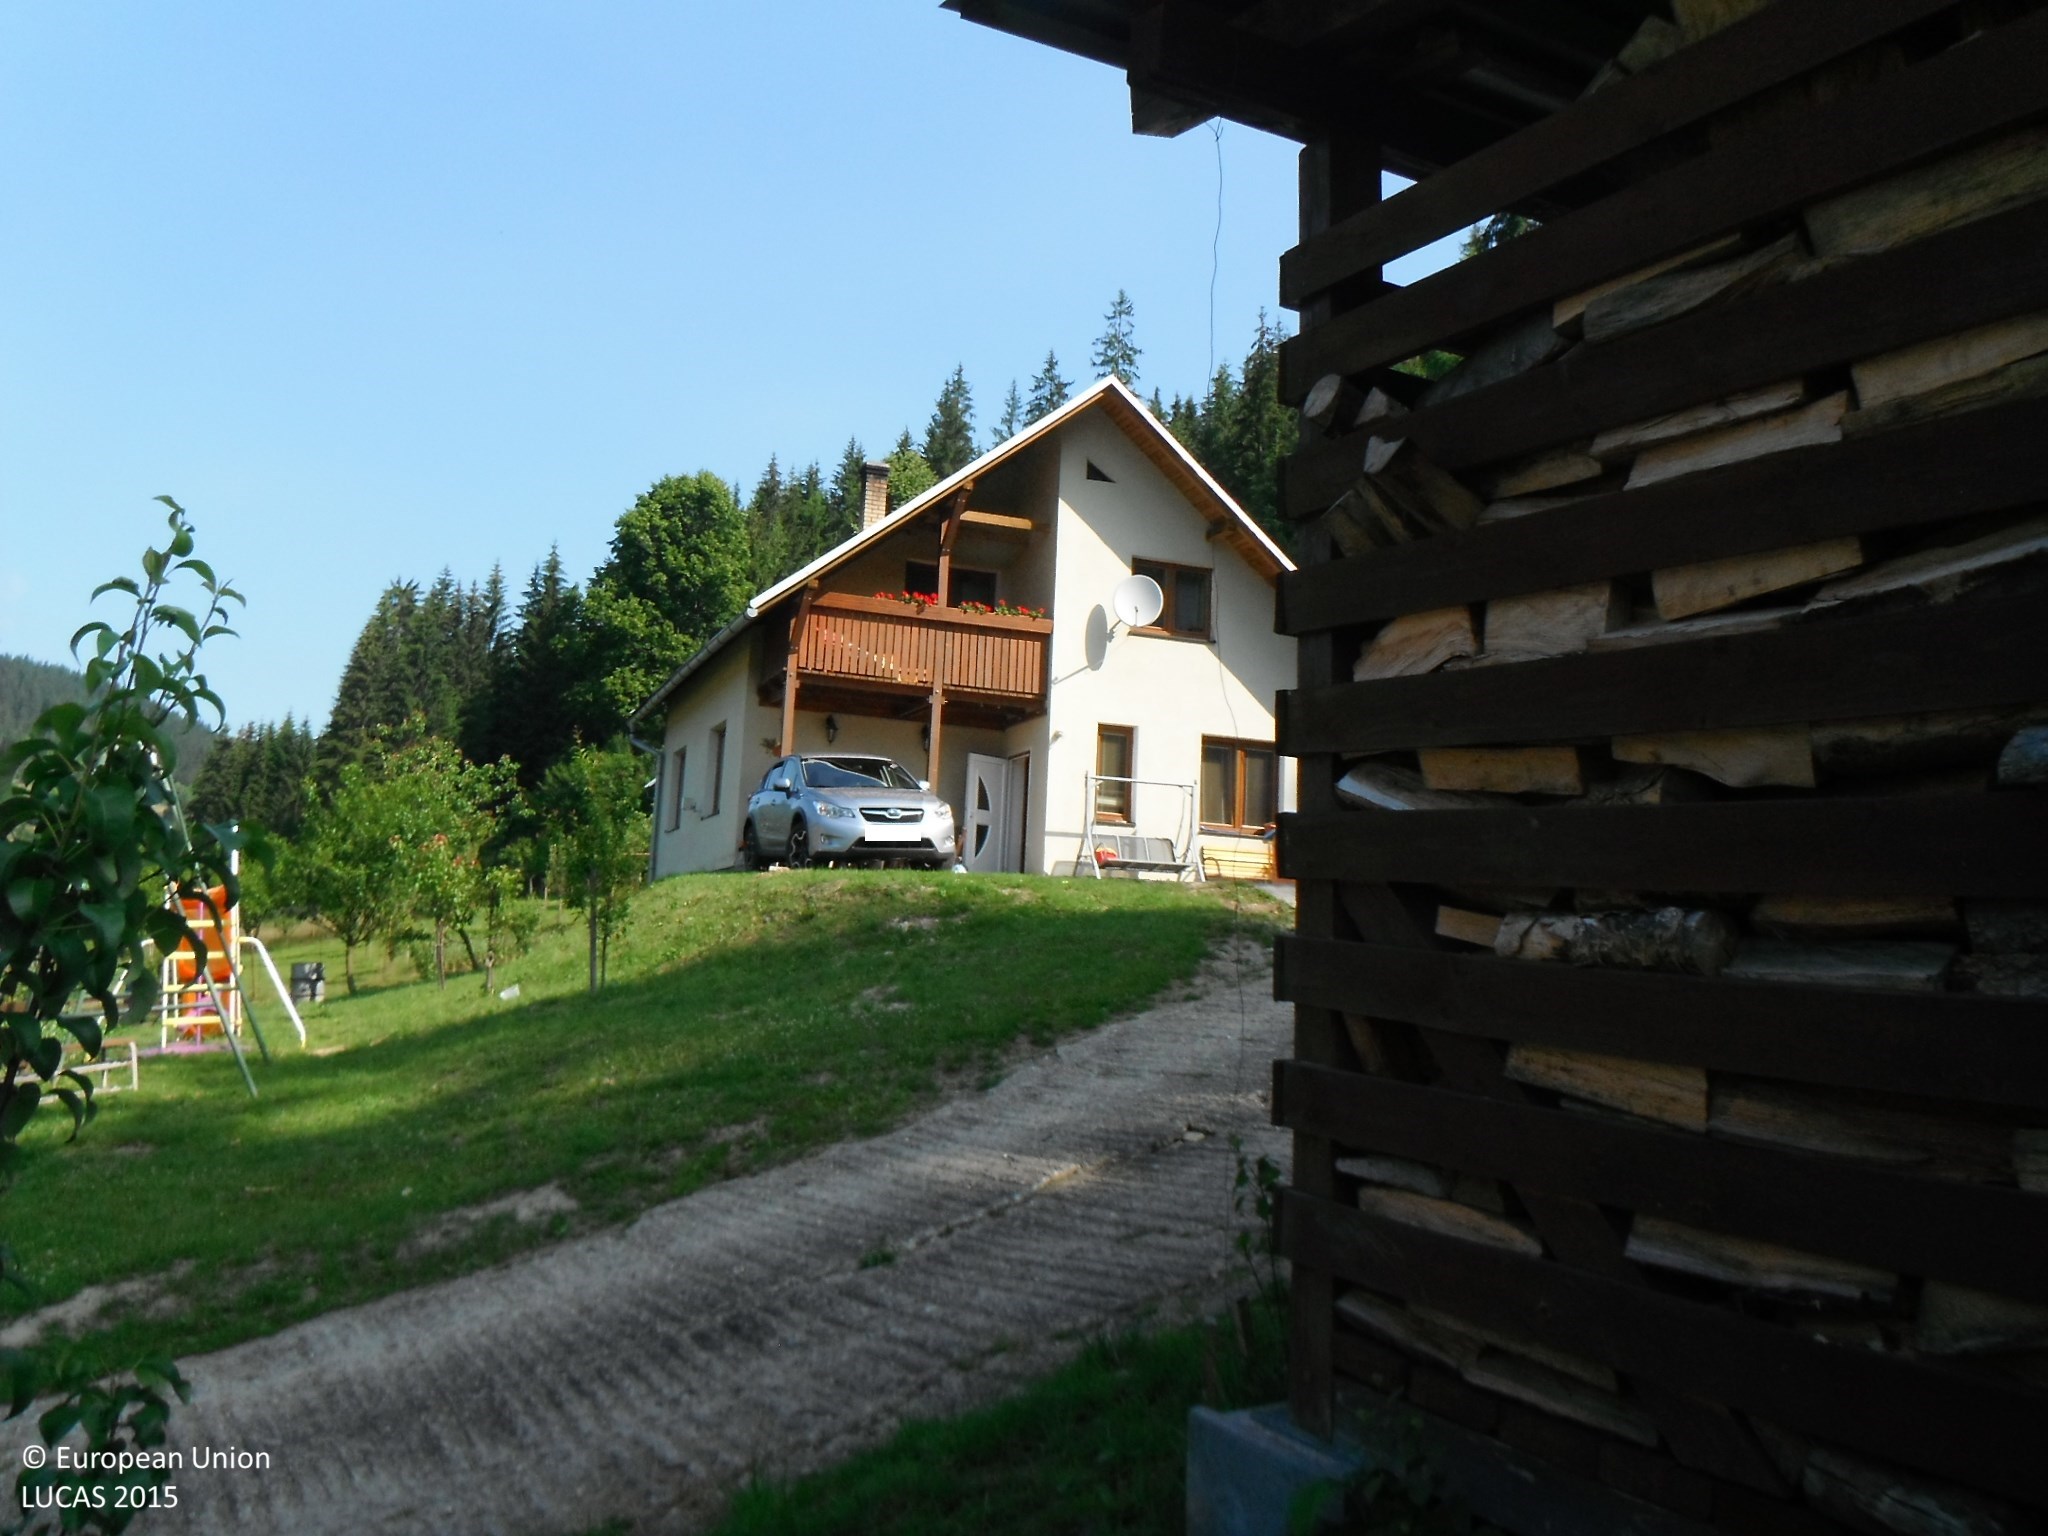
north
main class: Cropland
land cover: Other fruit trees and berries
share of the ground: 25 - 50 %
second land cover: Grassland without tree/shrub cover
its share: > 75 %
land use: Kitchen garden
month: July
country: SK
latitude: 49.3968
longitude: 18.4923
